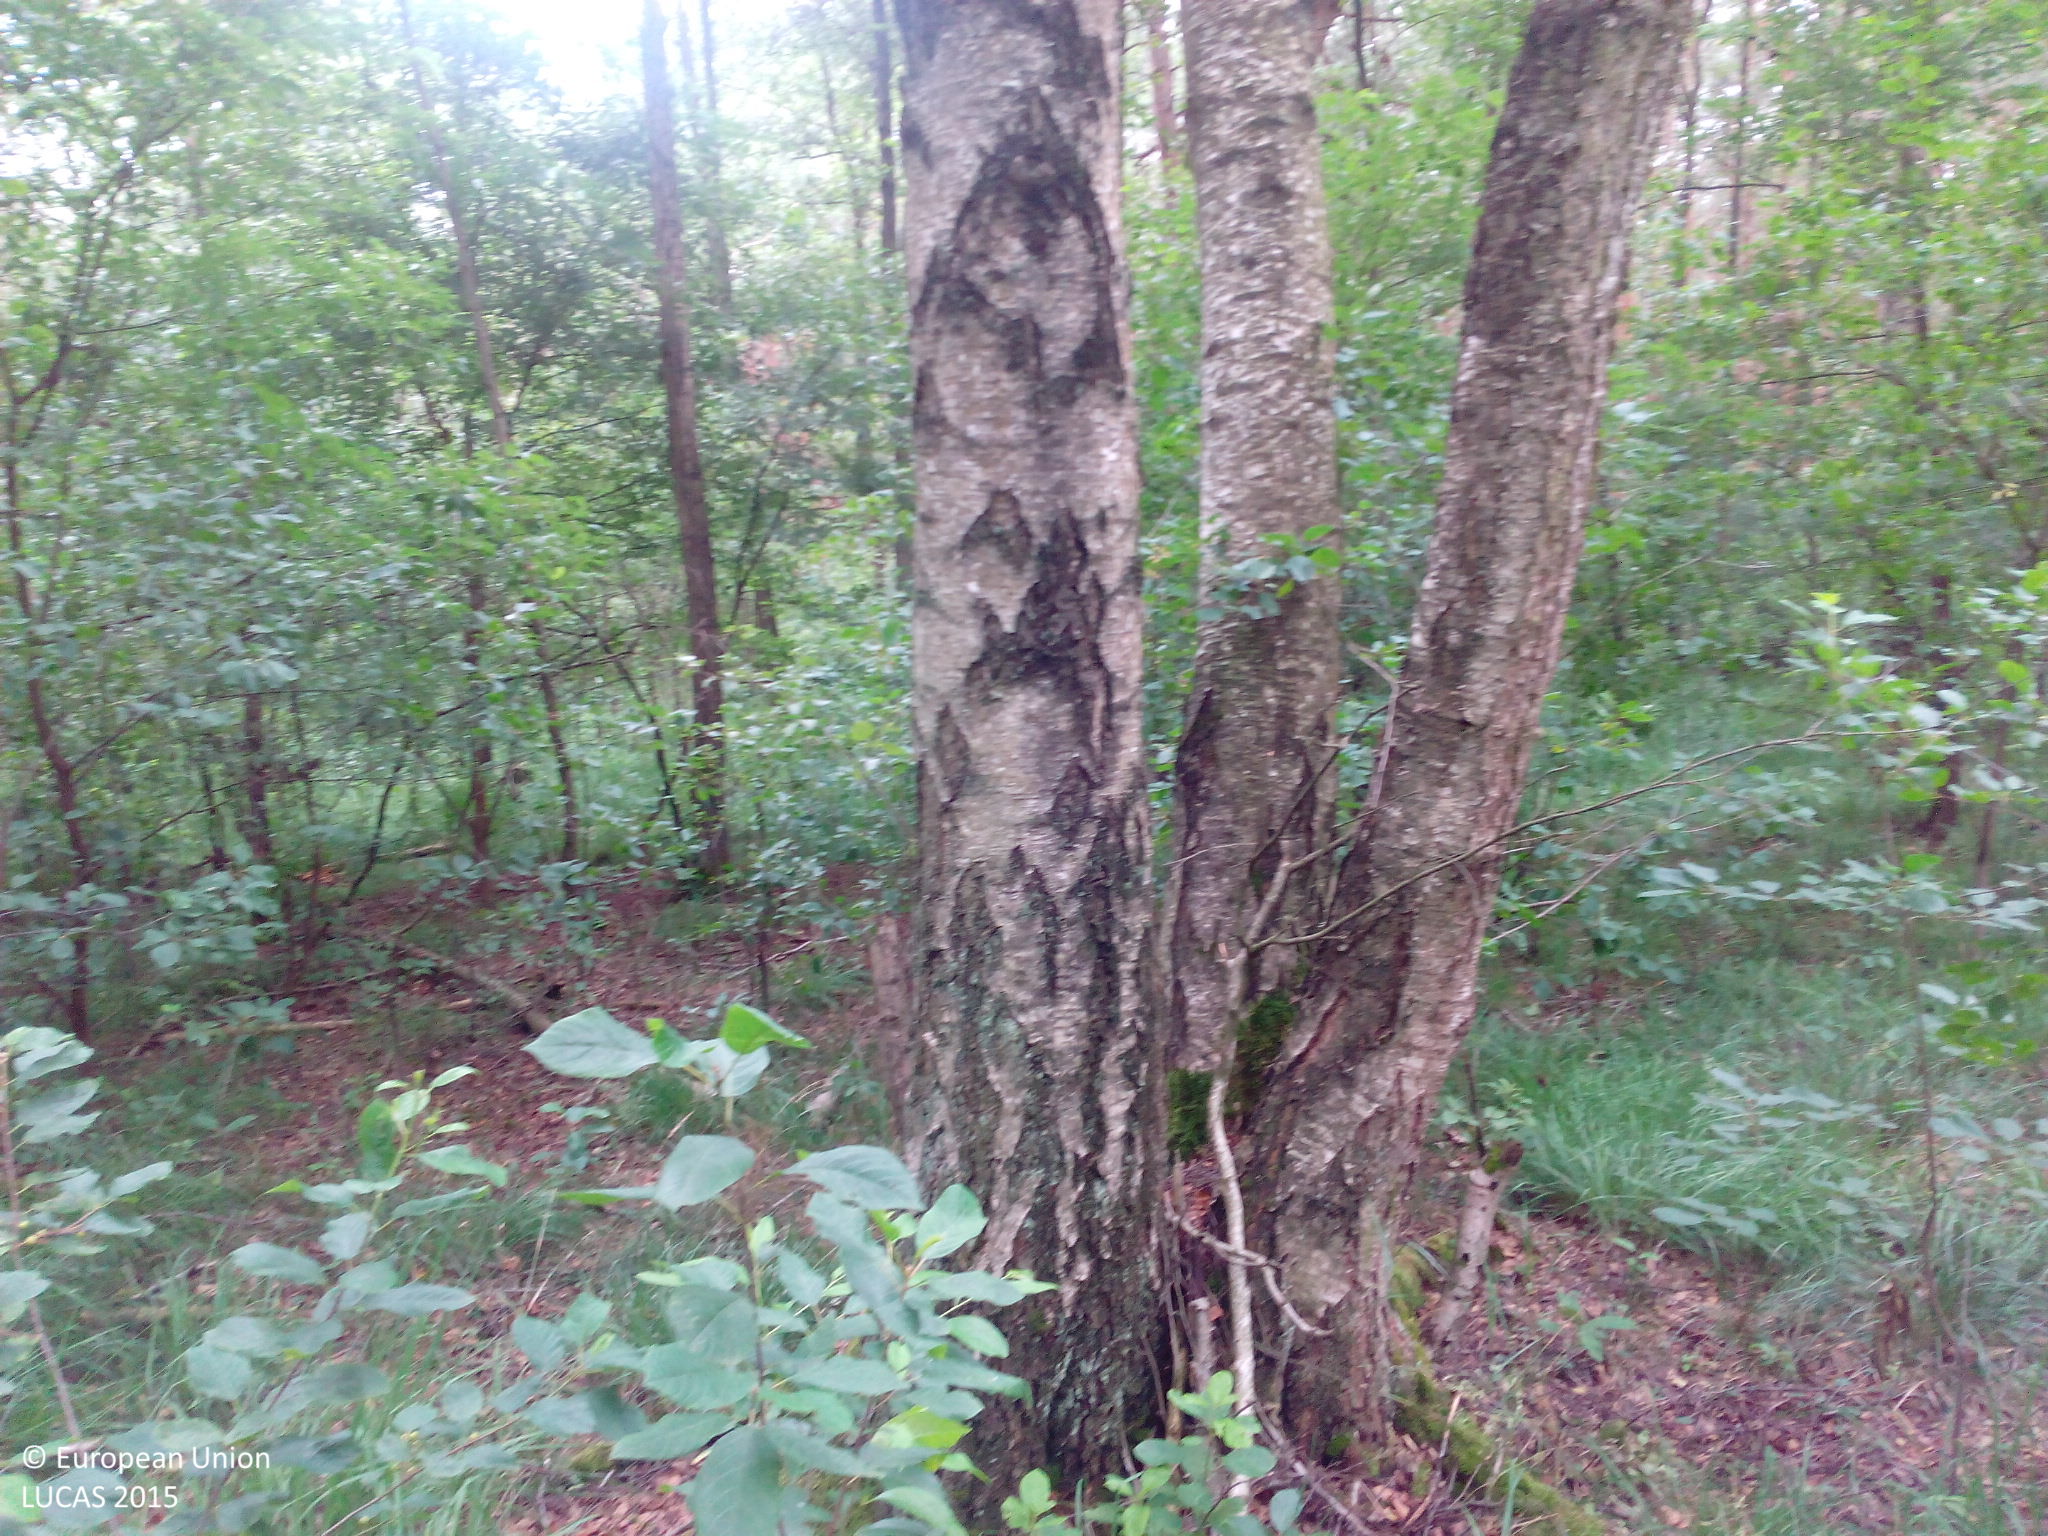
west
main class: Woodland
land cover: Broadleaved woodland
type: mesophytic deciduous forest
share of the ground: > 75 %
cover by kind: broadleaved forest trees 75 %, herbaceous plants 25 %
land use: Forestry
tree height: > 5 m
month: July
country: DE
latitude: 52.1444
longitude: 12.0308
